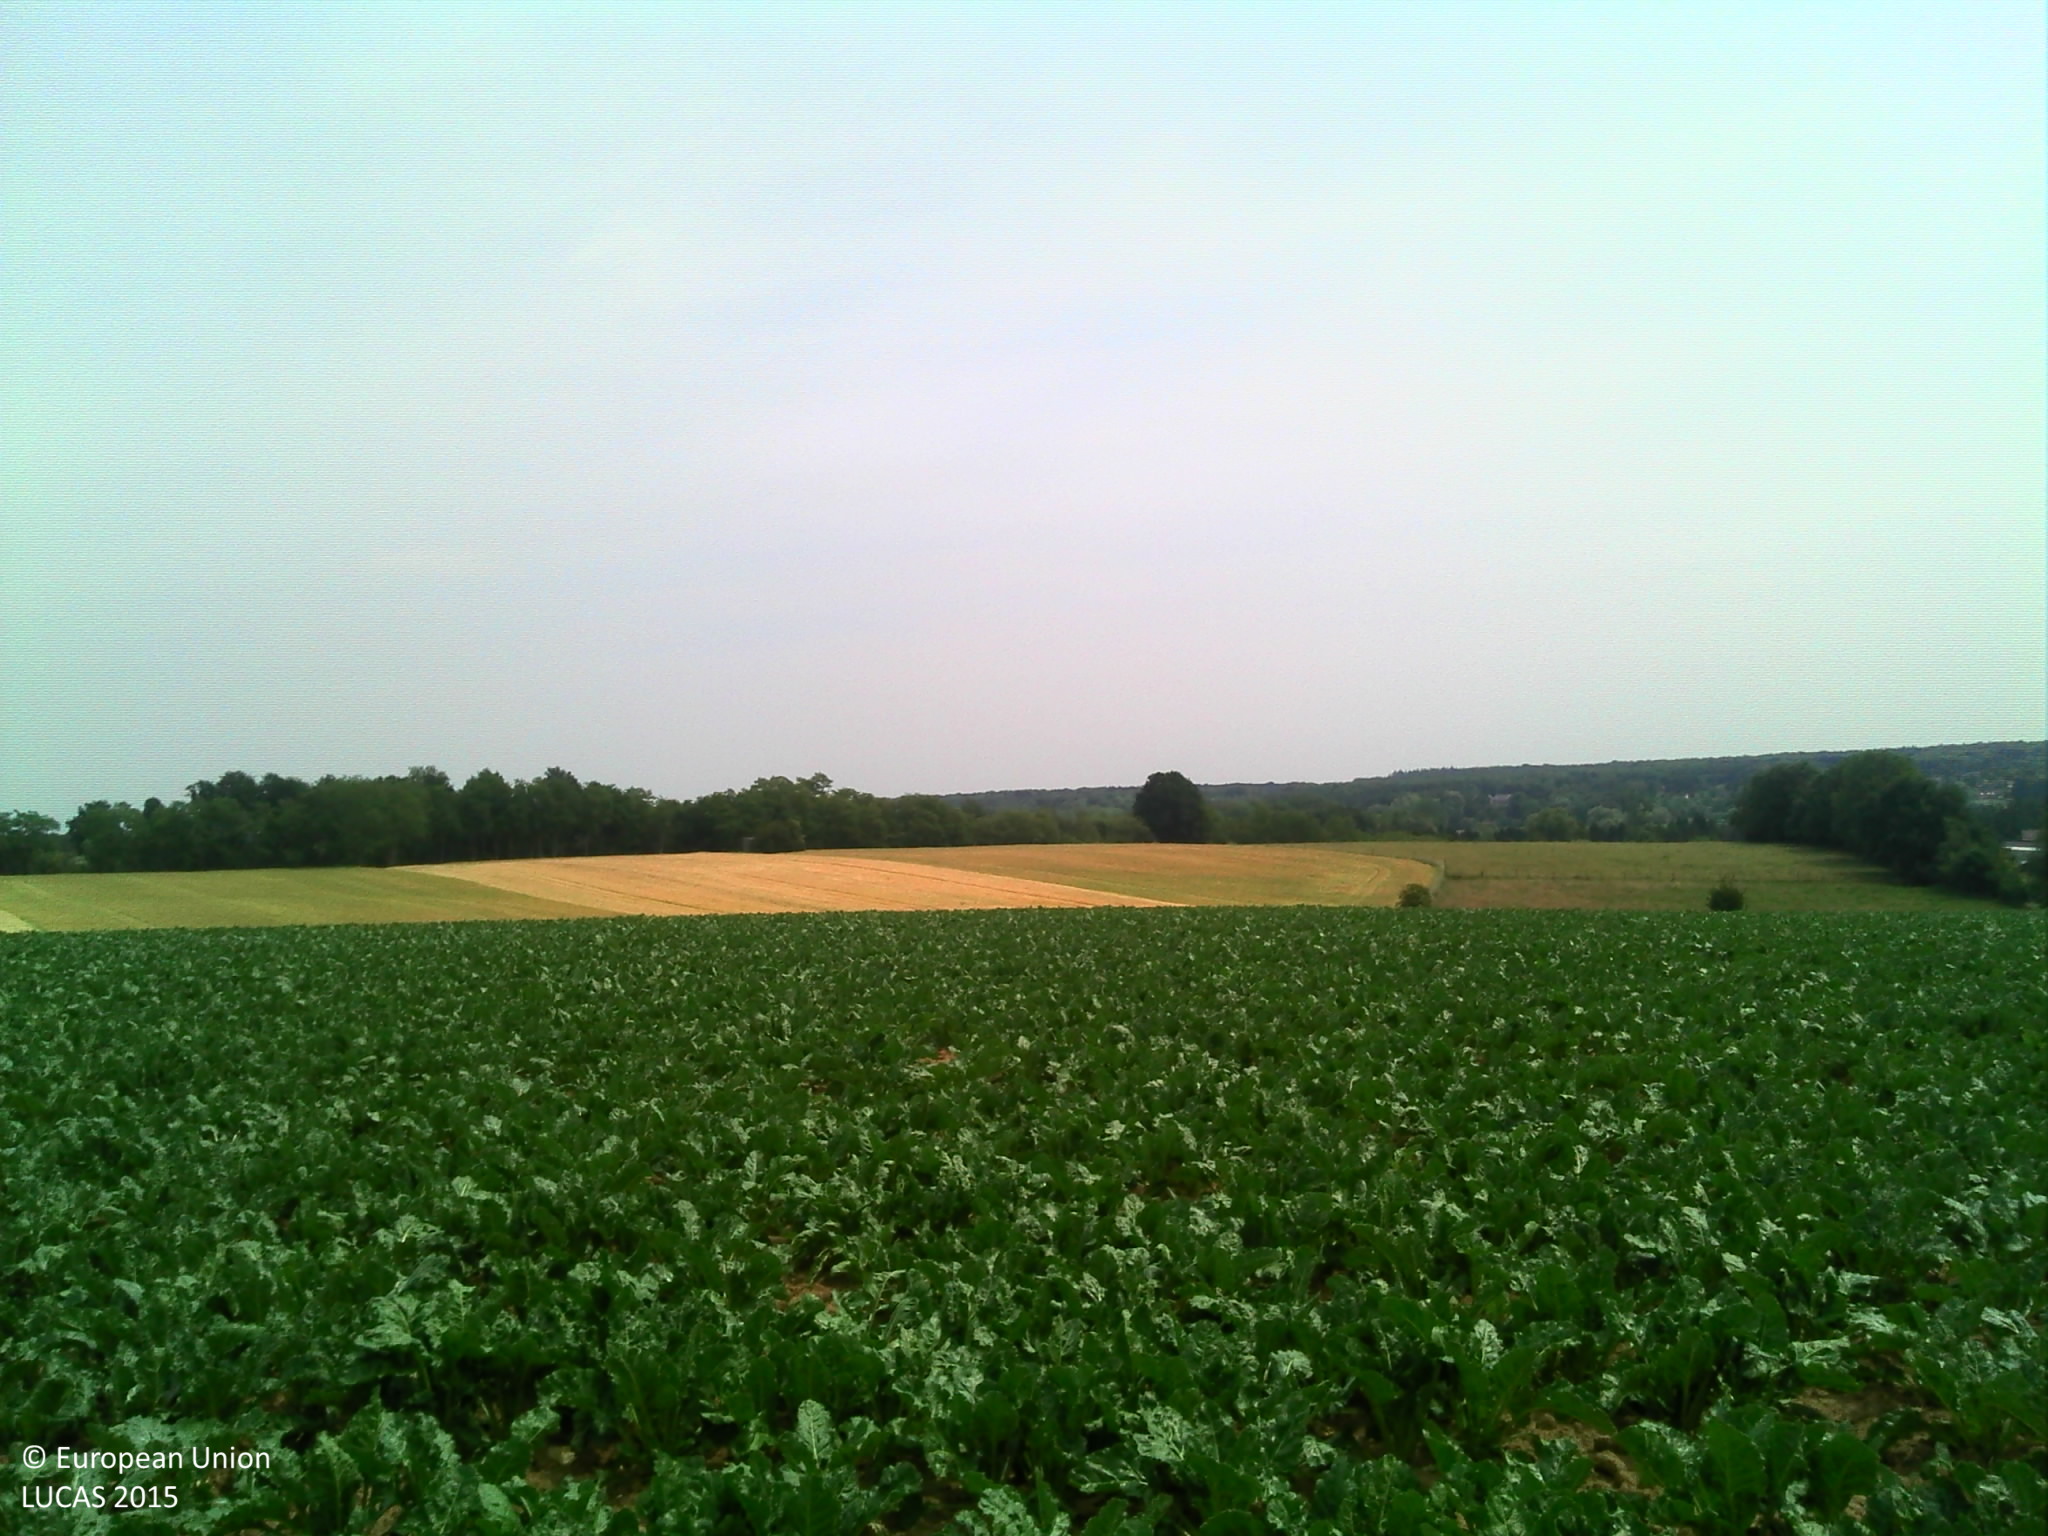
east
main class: Cropland
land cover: Sugar beet
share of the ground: > 75 %
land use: Agriculture (excluding fallow land and kitchen gardens)
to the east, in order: Sugar beet; Common wheat; Barley
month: June
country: BE
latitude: 50.8512
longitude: 4.6412
